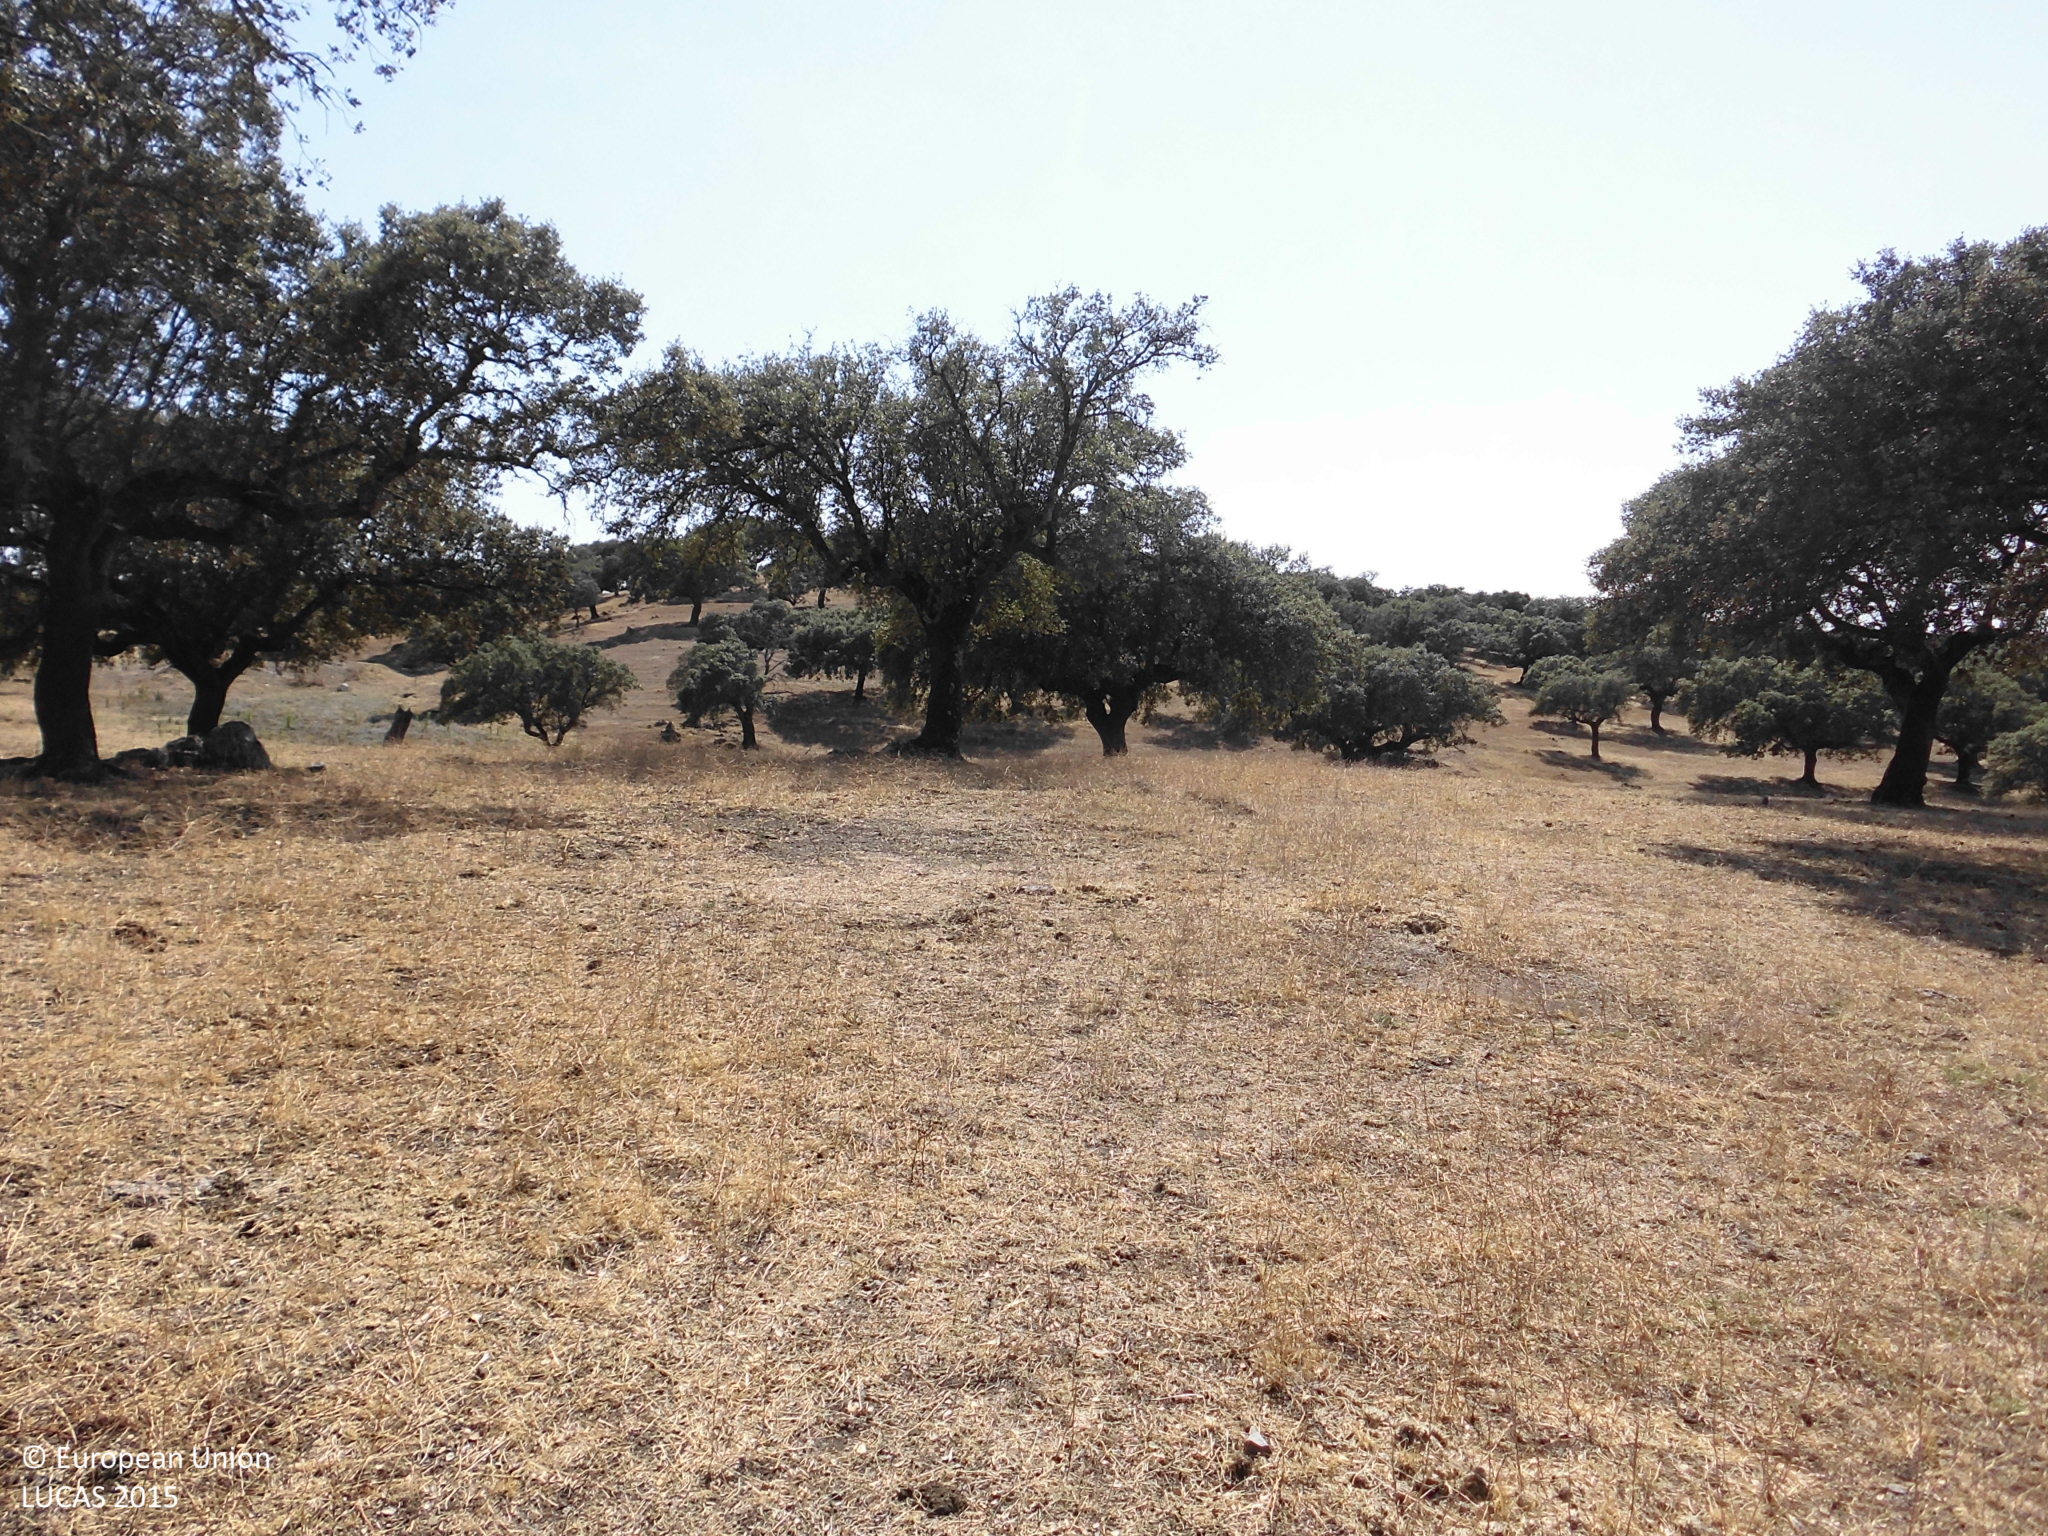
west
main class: Woodland
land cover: Broadleaved woodland
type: broadleaved evergreen forest
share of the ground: 25 - 50 %
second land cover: Grassland without tree/shrub cover
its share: > 75 %
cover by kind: herbaceous plants 70 %, broadleaved forest trees 25 %, unconsolidated bare surface 5 %
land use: Forestry
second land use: Agriculture (excluding fallow land and kitchen gardens)
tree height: > 5 m
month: June
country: ES
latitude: 39.9438
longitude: -6.1880
